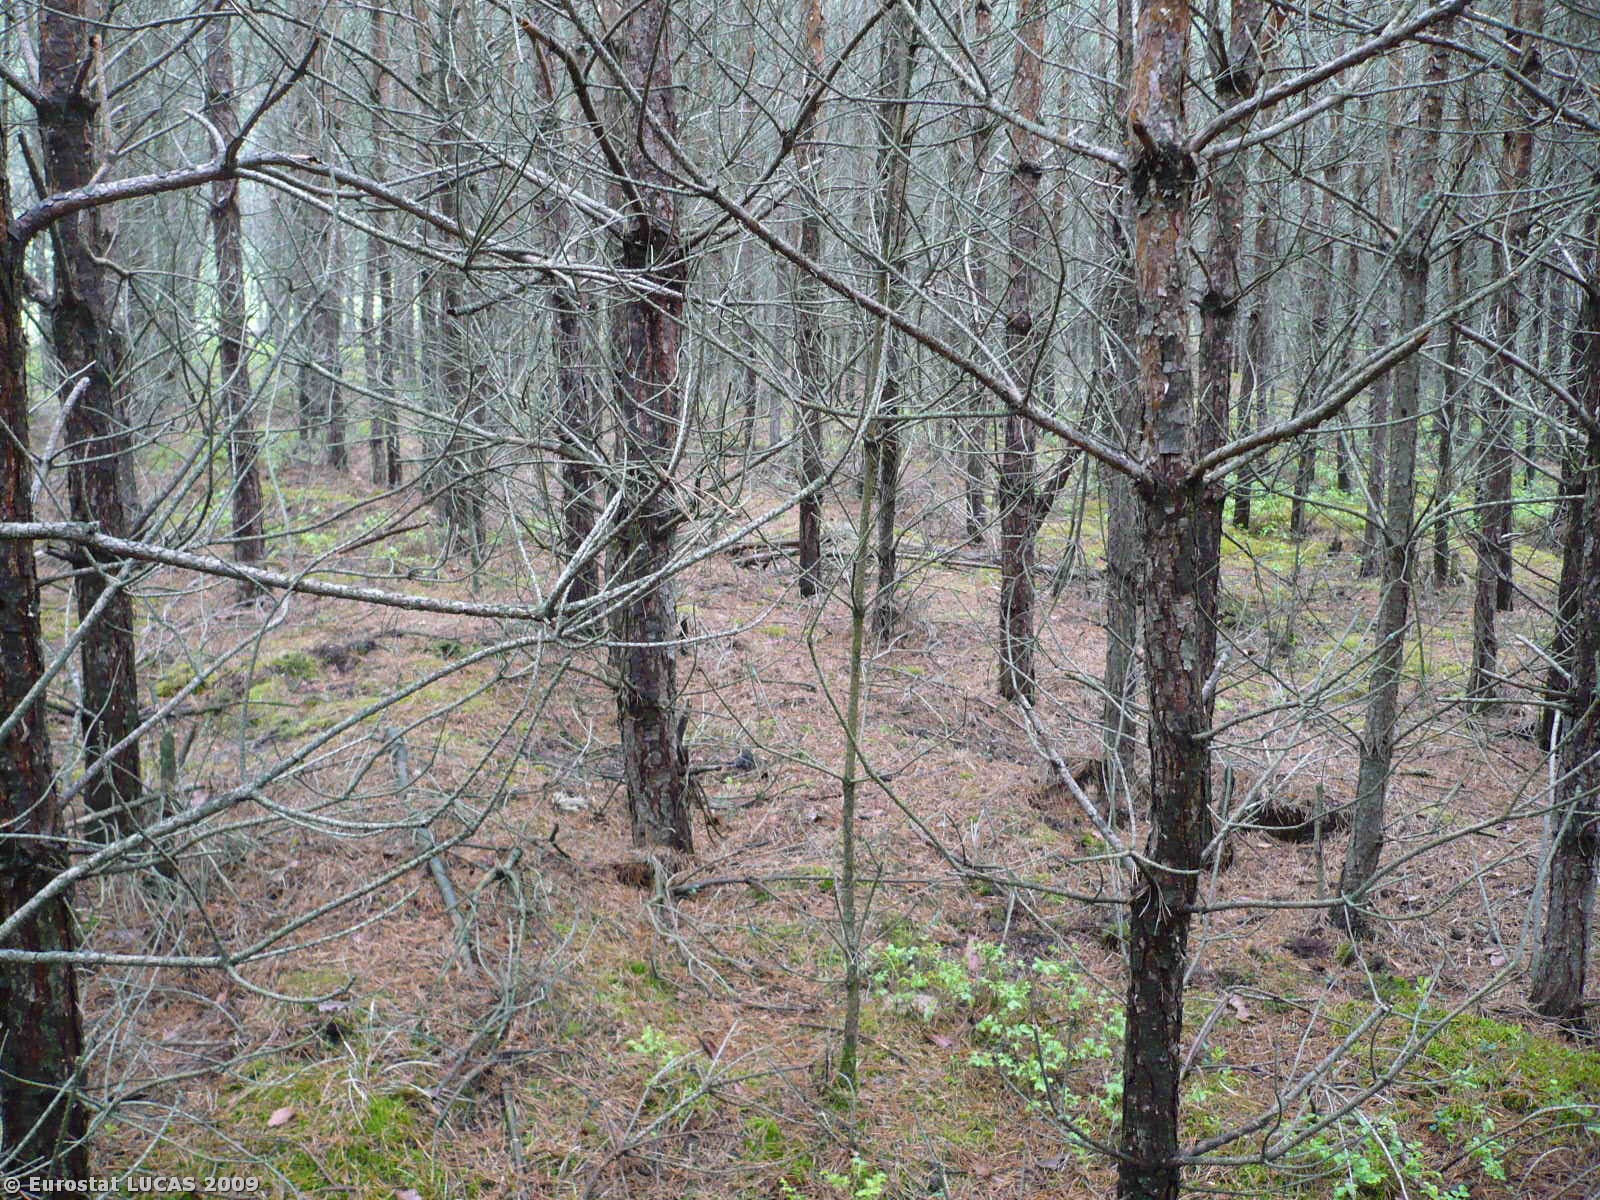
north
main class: Woodland
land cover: Coniferous woodland
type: hemiboreal forest and nemoral coniferous forest and mixed broadleaved-coniferous forest
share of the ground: > 75 %
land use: Forestry
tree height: > 5 m
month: May
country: PL
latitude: 51.9702
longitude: 15.3166
